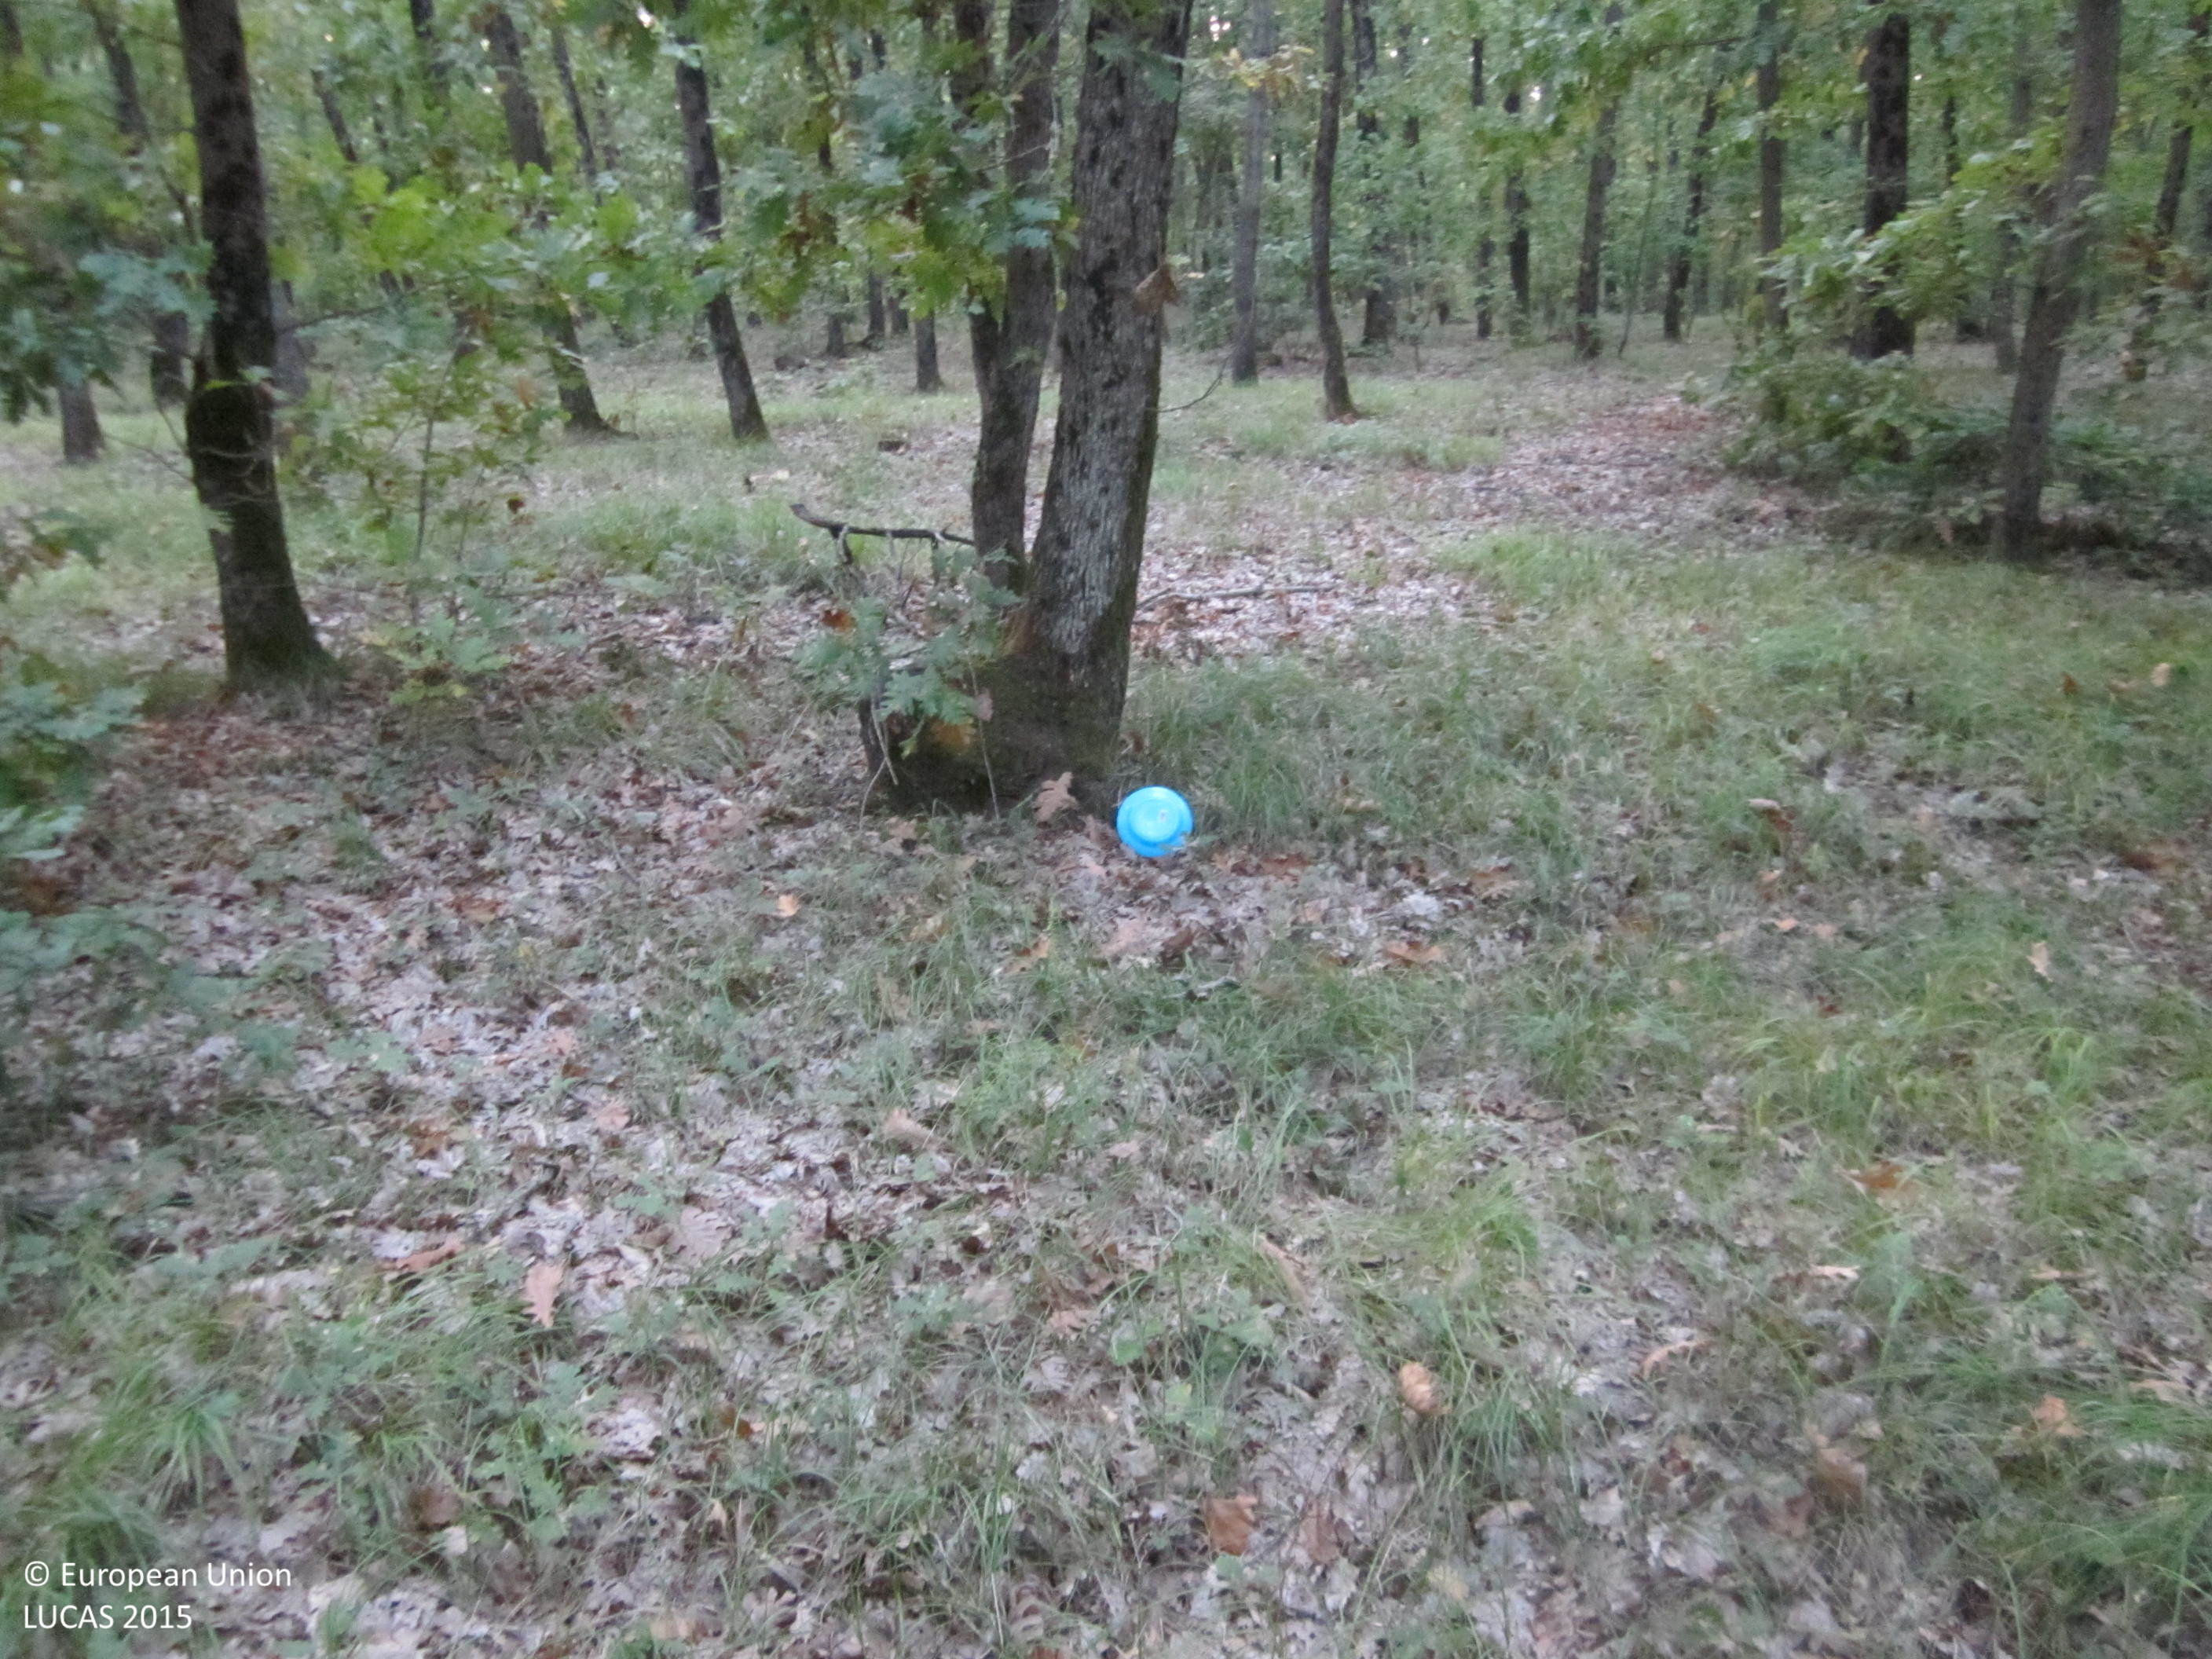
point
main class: Woodland
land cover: Broadleaved woodland
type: thermophilous deciduous forest
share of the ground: > 75 %
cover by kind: broadleaved forest trees 90 %, herbaceous plants 5 %, unconsolidated bare surface 5 %
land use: Forestry
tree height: > 5 m
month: September
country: BG
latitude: 42.2332
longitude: 27.7514
